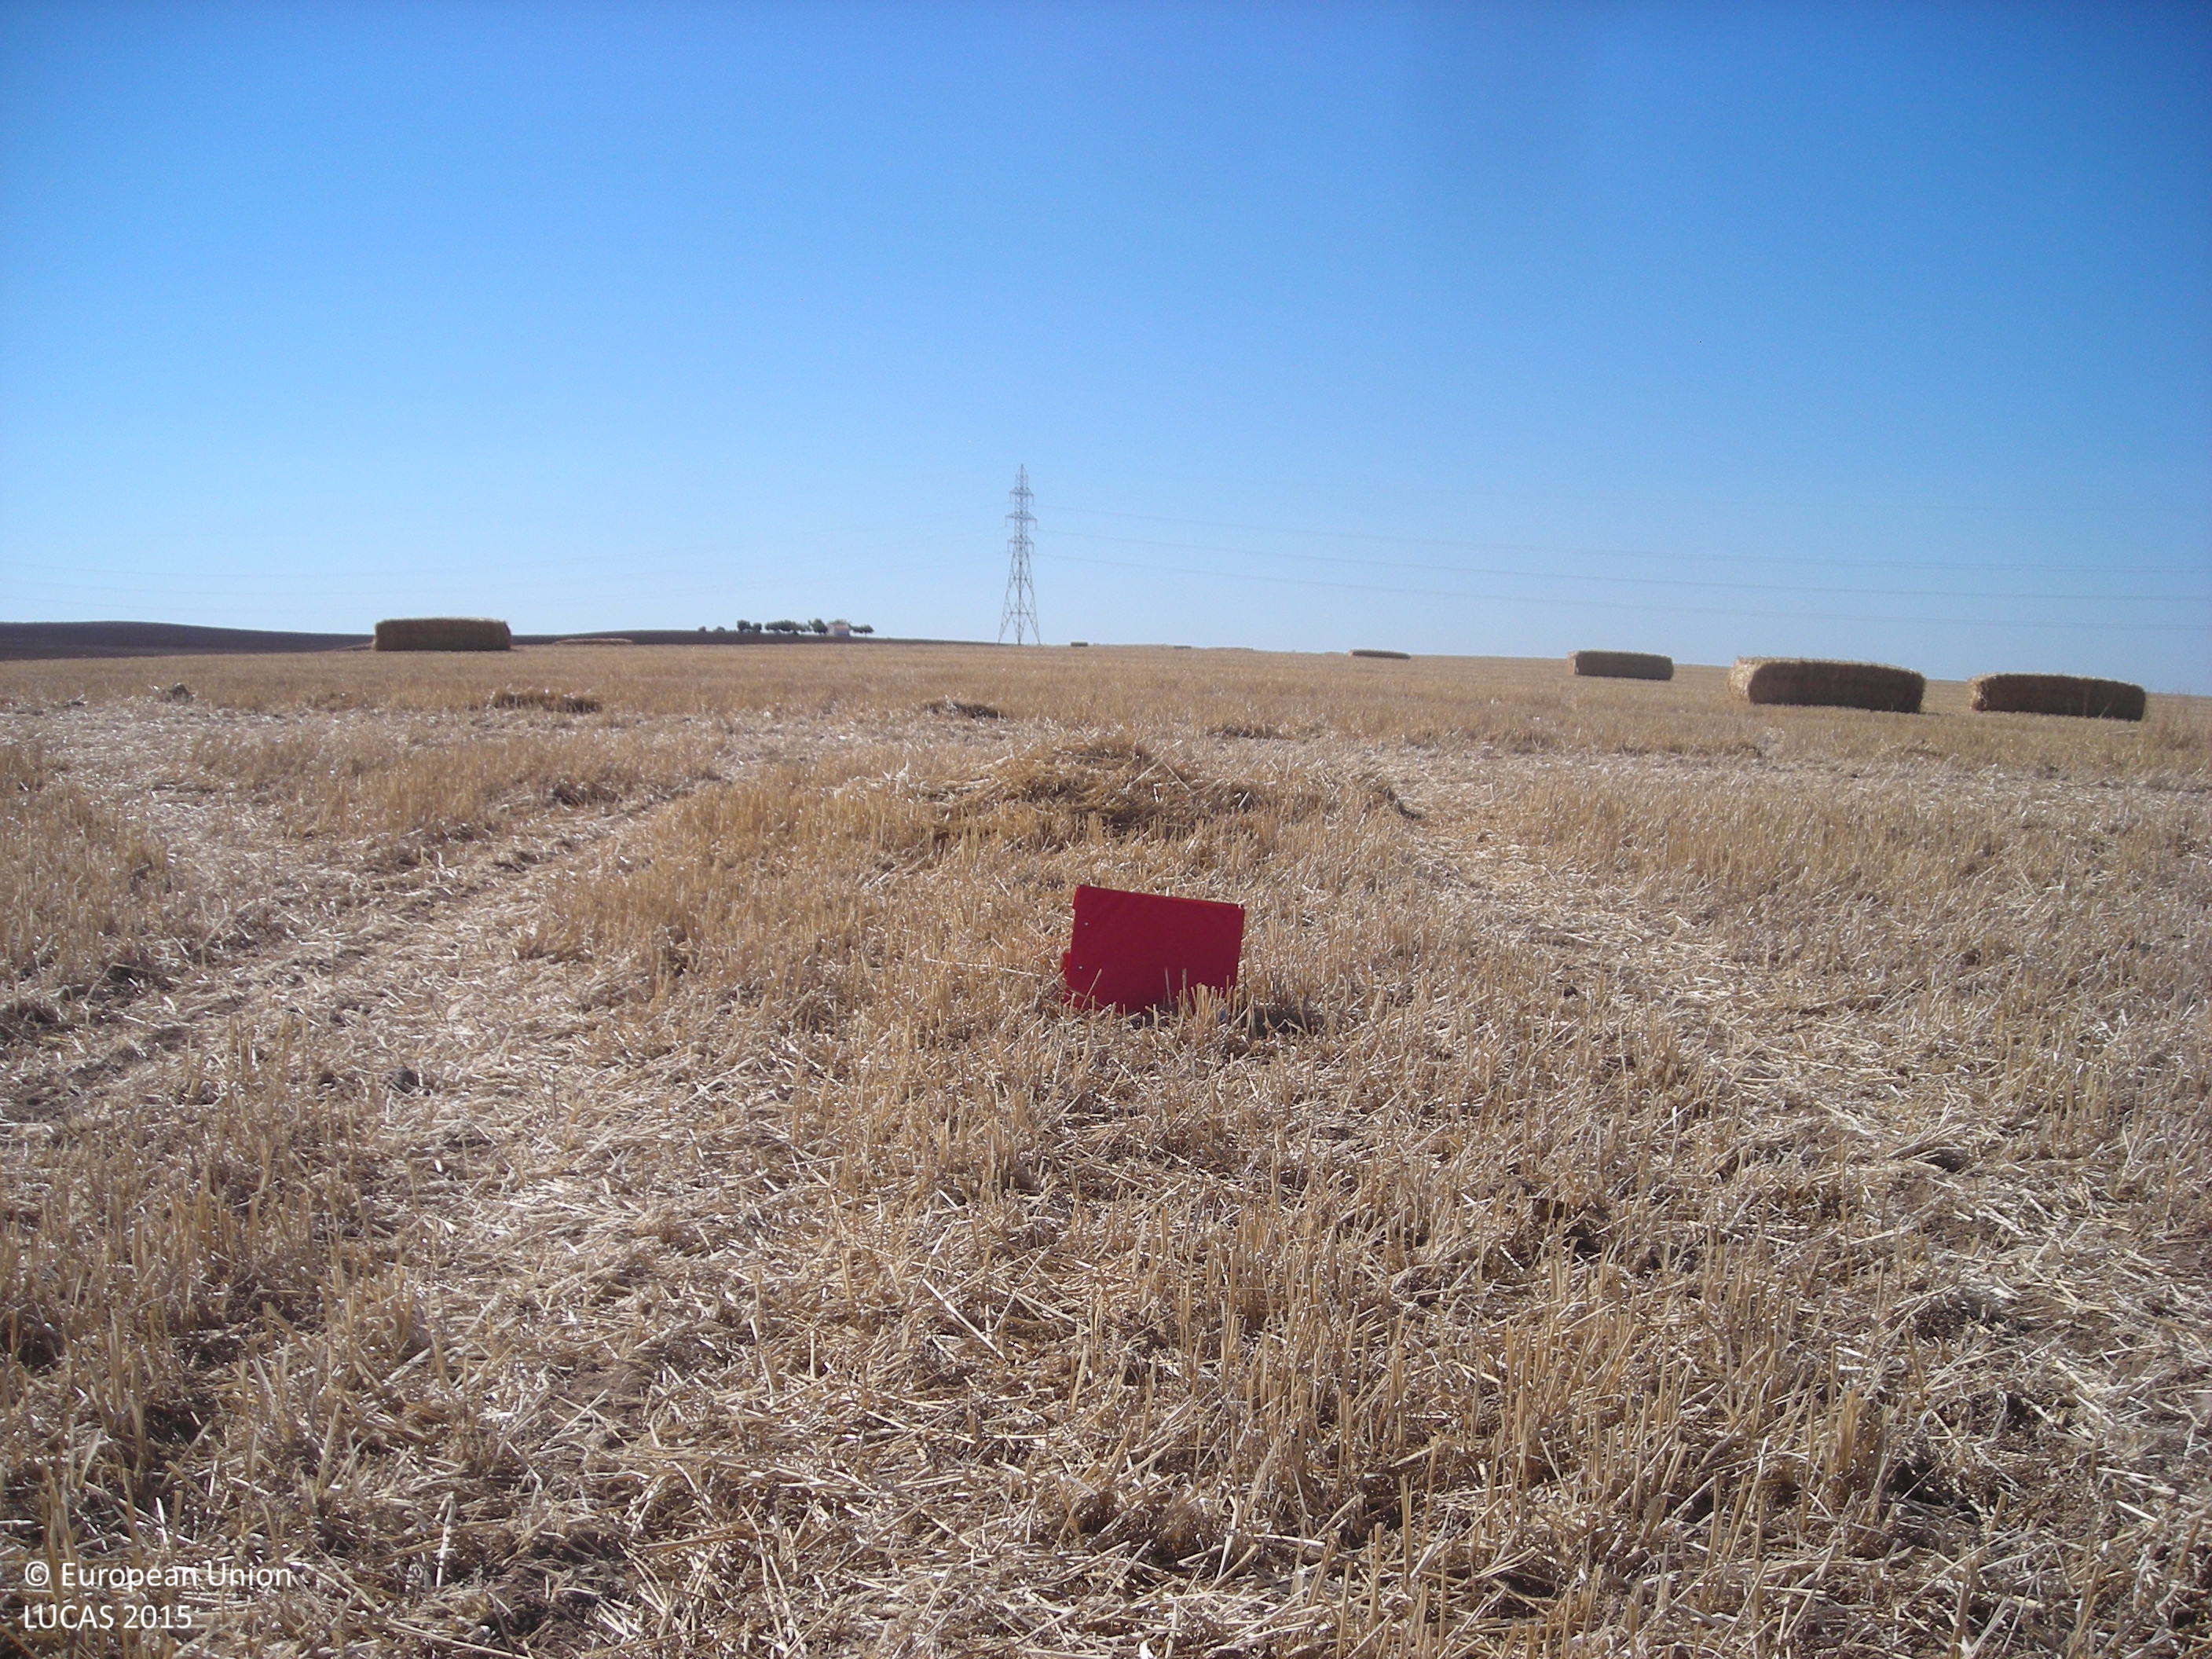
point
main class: Cropland
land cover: Common wheat
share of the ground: > 75 %
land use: Agriculture (excluding fallow land and kitchen gardens)
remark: Harvested field
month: July
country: ES
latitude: 38.9455
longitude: -5.7737
